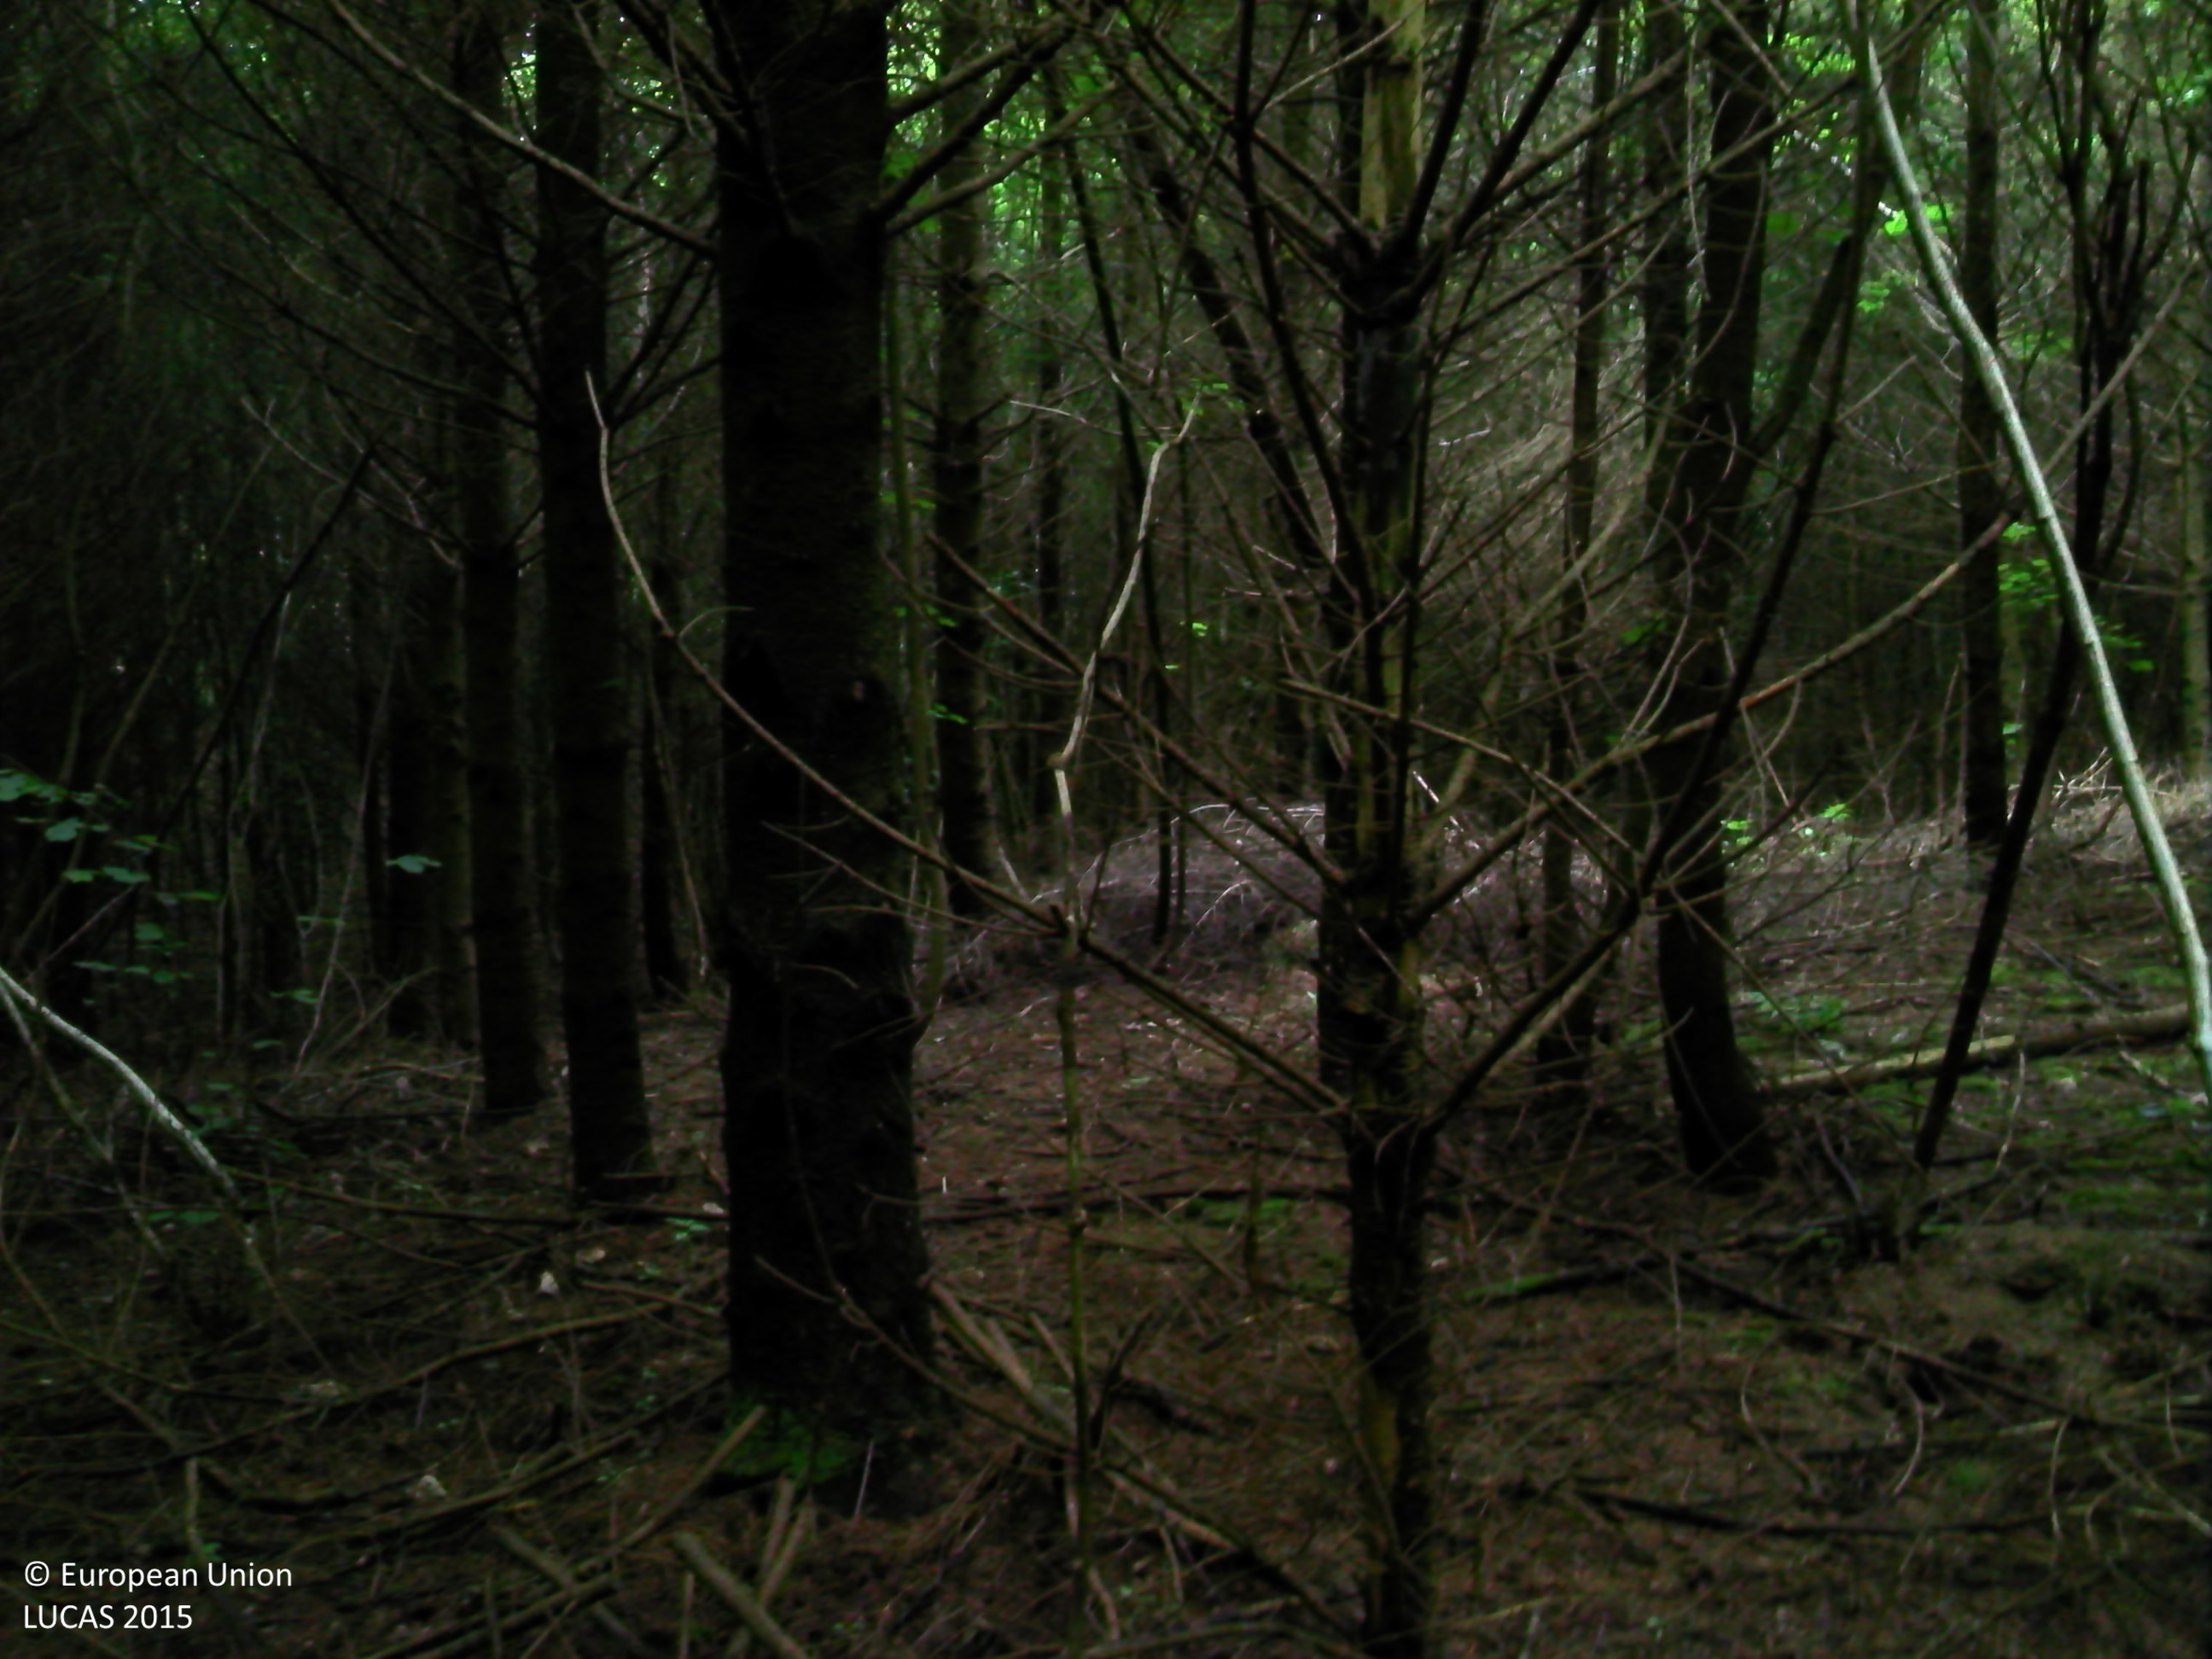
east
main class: Woodland
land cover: Spruce dominated coniferous woodland
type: exotic forest
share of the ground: > 75 %
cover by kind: coniferous forest trees 80 %, broadleaved forest trees 10 %, lichens and mosses 10 %
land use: Forestry
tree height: > 5 m
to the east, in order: Spruce dominated coniferous woodland; Spruce dominated mixed woodland; Broadleaved woodland; Fences; Grassland without tree/shrub cover; Common wheat
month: June
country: BE
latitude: 50.4906
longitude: 5.4735
